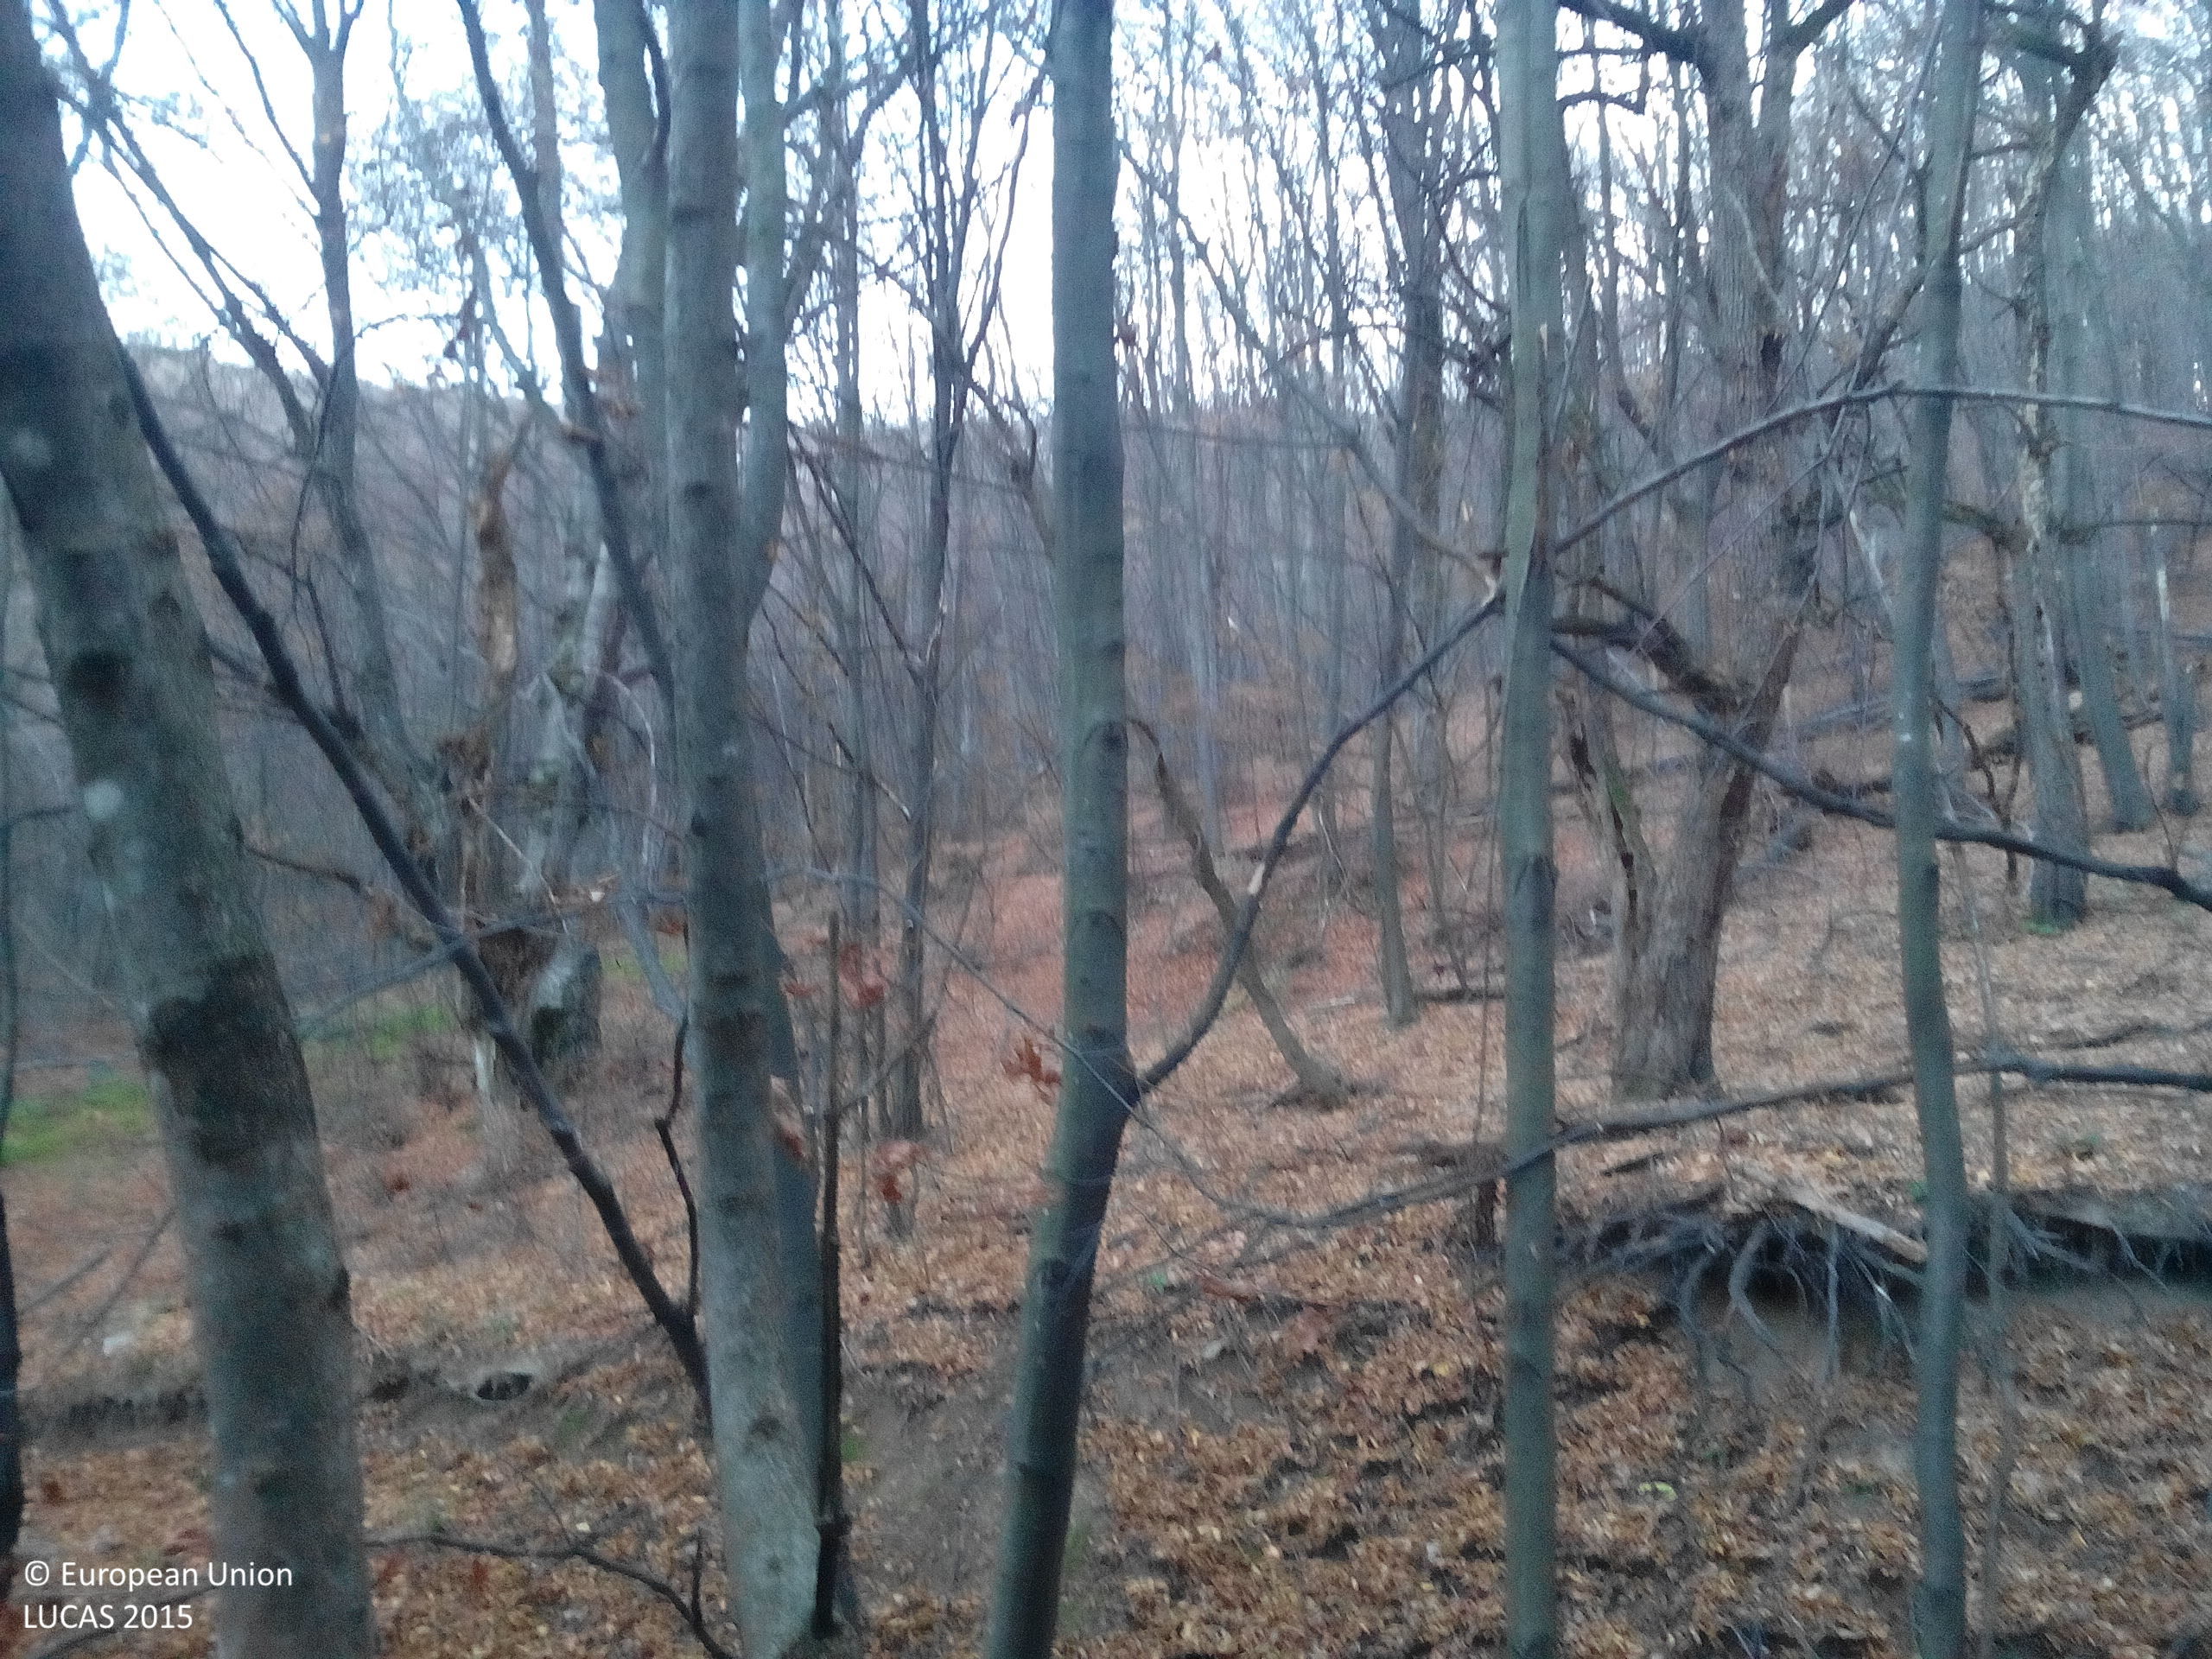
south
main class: Woodland
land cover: Broadleaved woodland
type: mesophytic deciduous forest
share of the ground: > 75 %
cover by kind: broadleaved forest trees 100 %
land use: Forestry
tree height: > 5 m
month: November
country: BG
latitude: 43.0343
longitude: 23.7038
